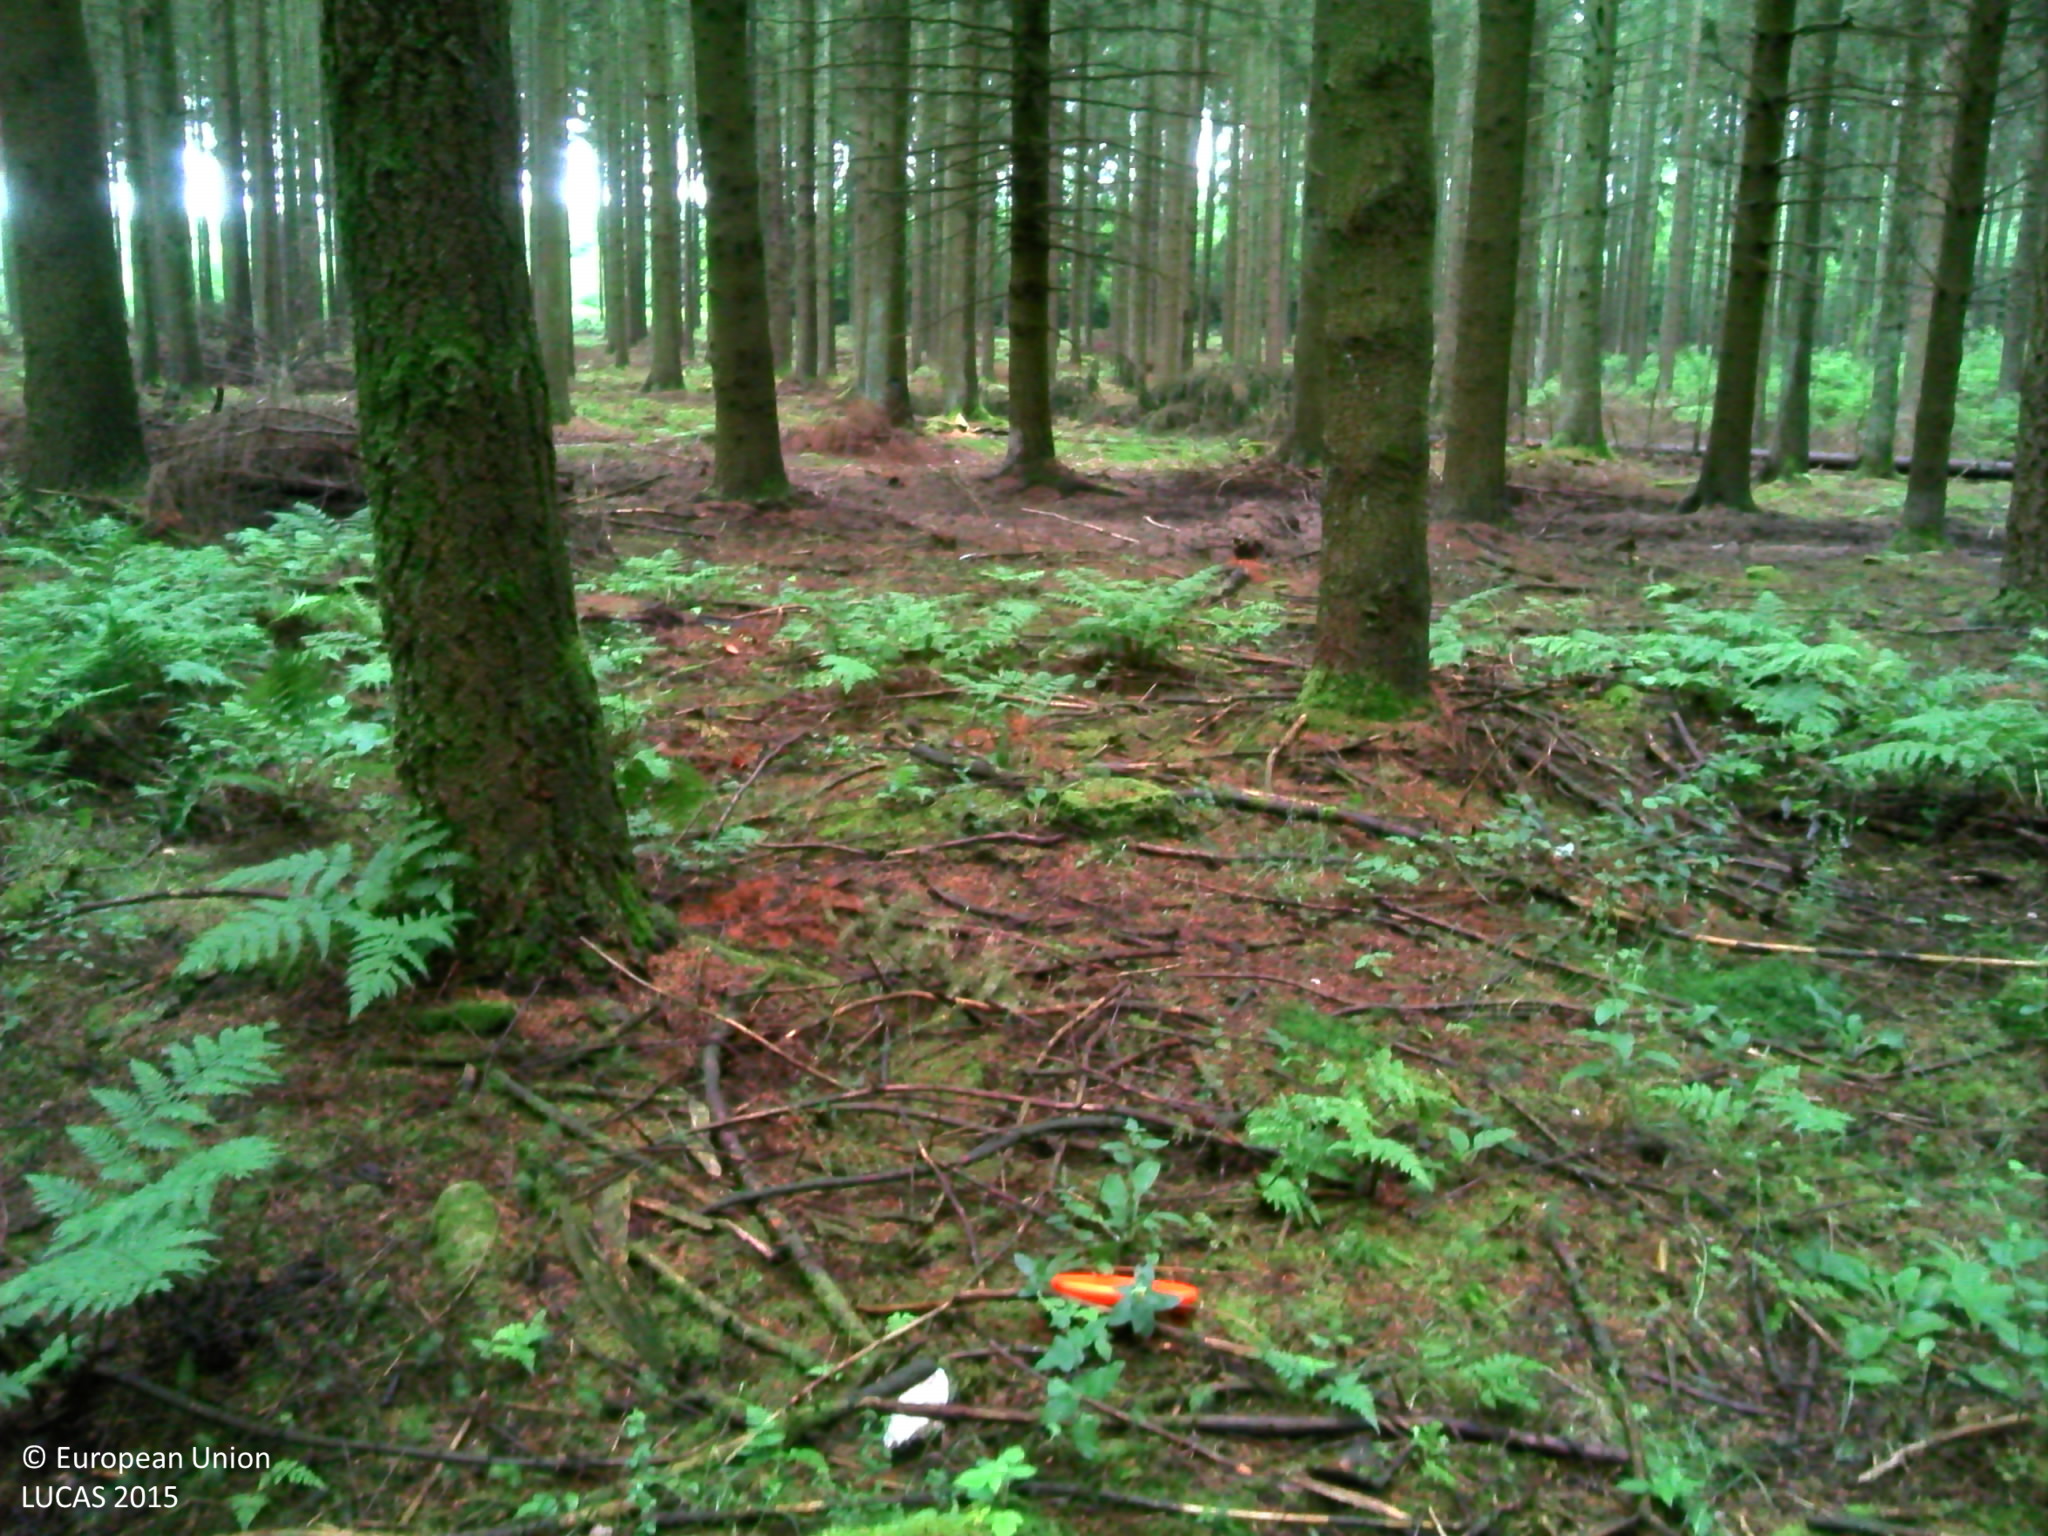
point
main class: Woodland
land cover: Other coniferous woodland
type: exotic forest
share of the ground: > 75 %
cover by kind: coniferous forest trees 95 %, herbaceous plants 5 %
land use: Forestry
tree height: > 5 m
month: July
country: BE
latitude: 50.1235
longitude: 5.7606
